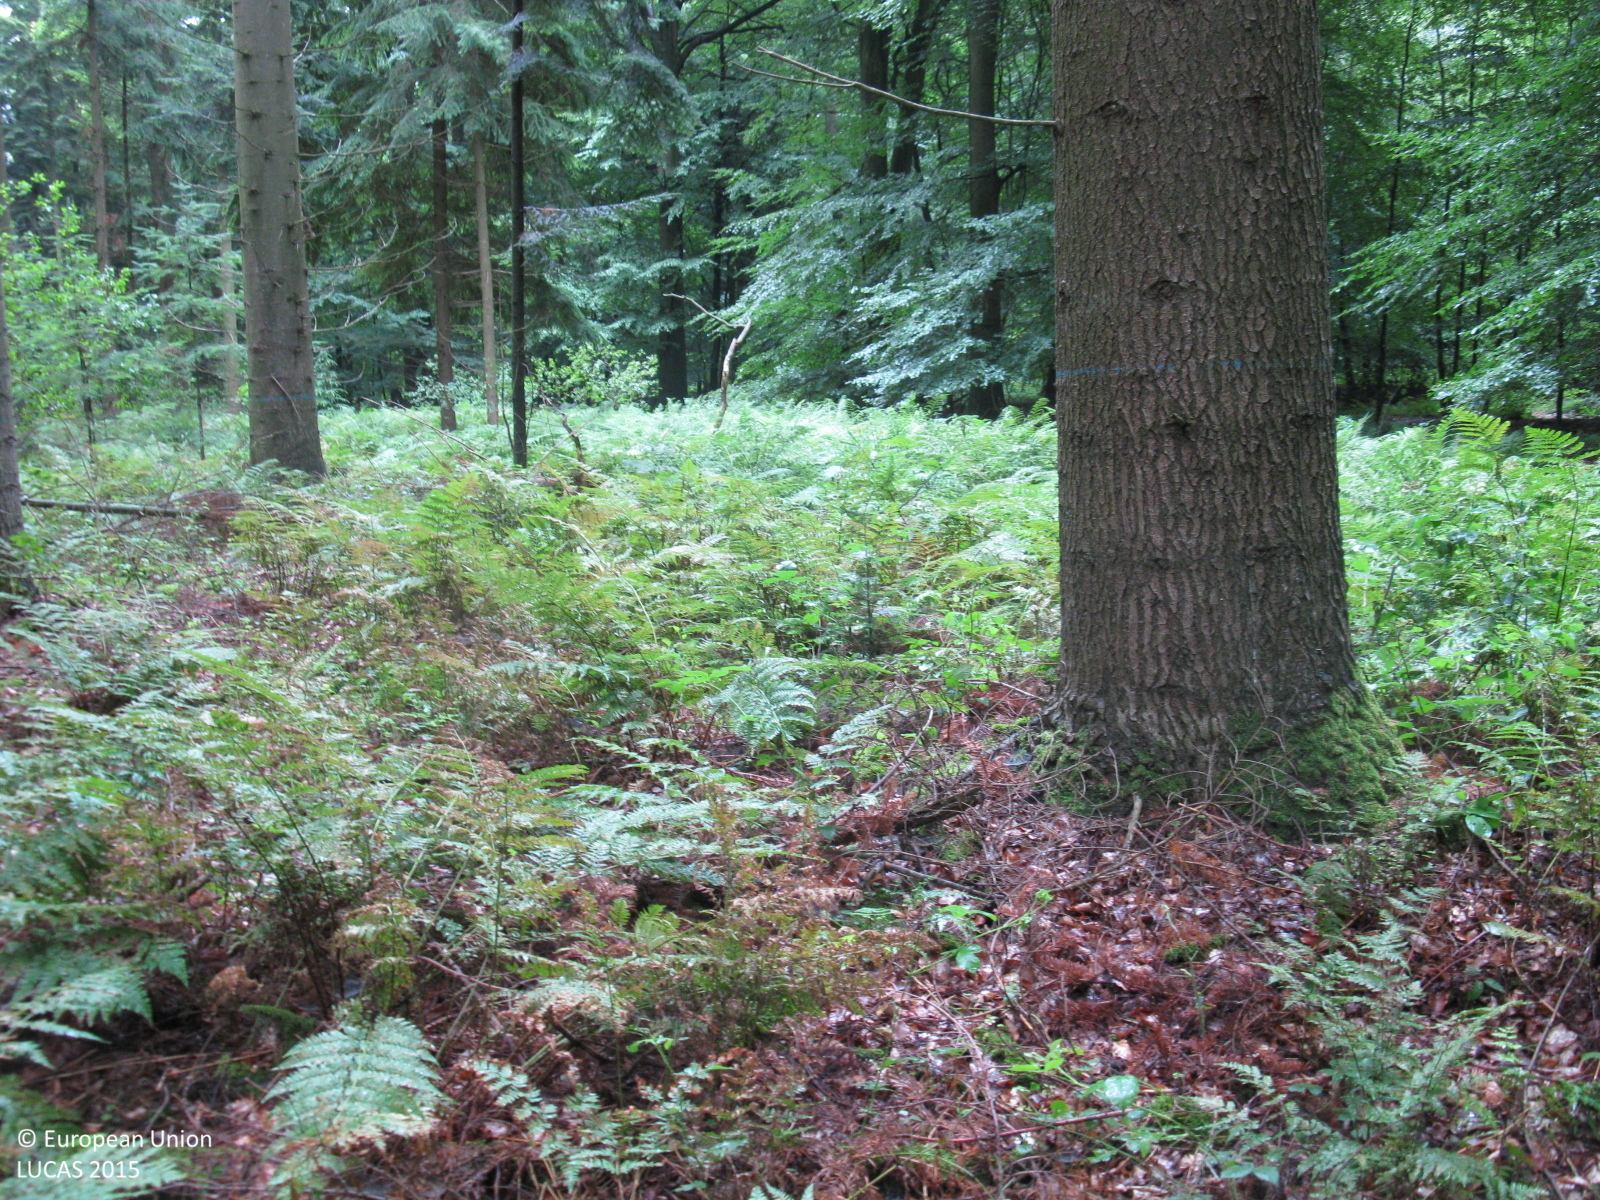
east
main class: Woodland
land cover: Other coniferous woodland
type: hemiboreal forest and nemoral coniferous forest and mixed broadleaved-coniferous forest
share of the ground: > 75 %
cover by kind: coniferous forest trees 100 %
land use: Forestry
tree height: > 5 m
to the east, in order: Other coniferous woodland; Broadleaved woodland; Other mixed woodland; Paved roads, cycling and walking lanes; Other coniferous woodland
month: July
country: DE
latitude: 52.9263
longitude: 8.5874
